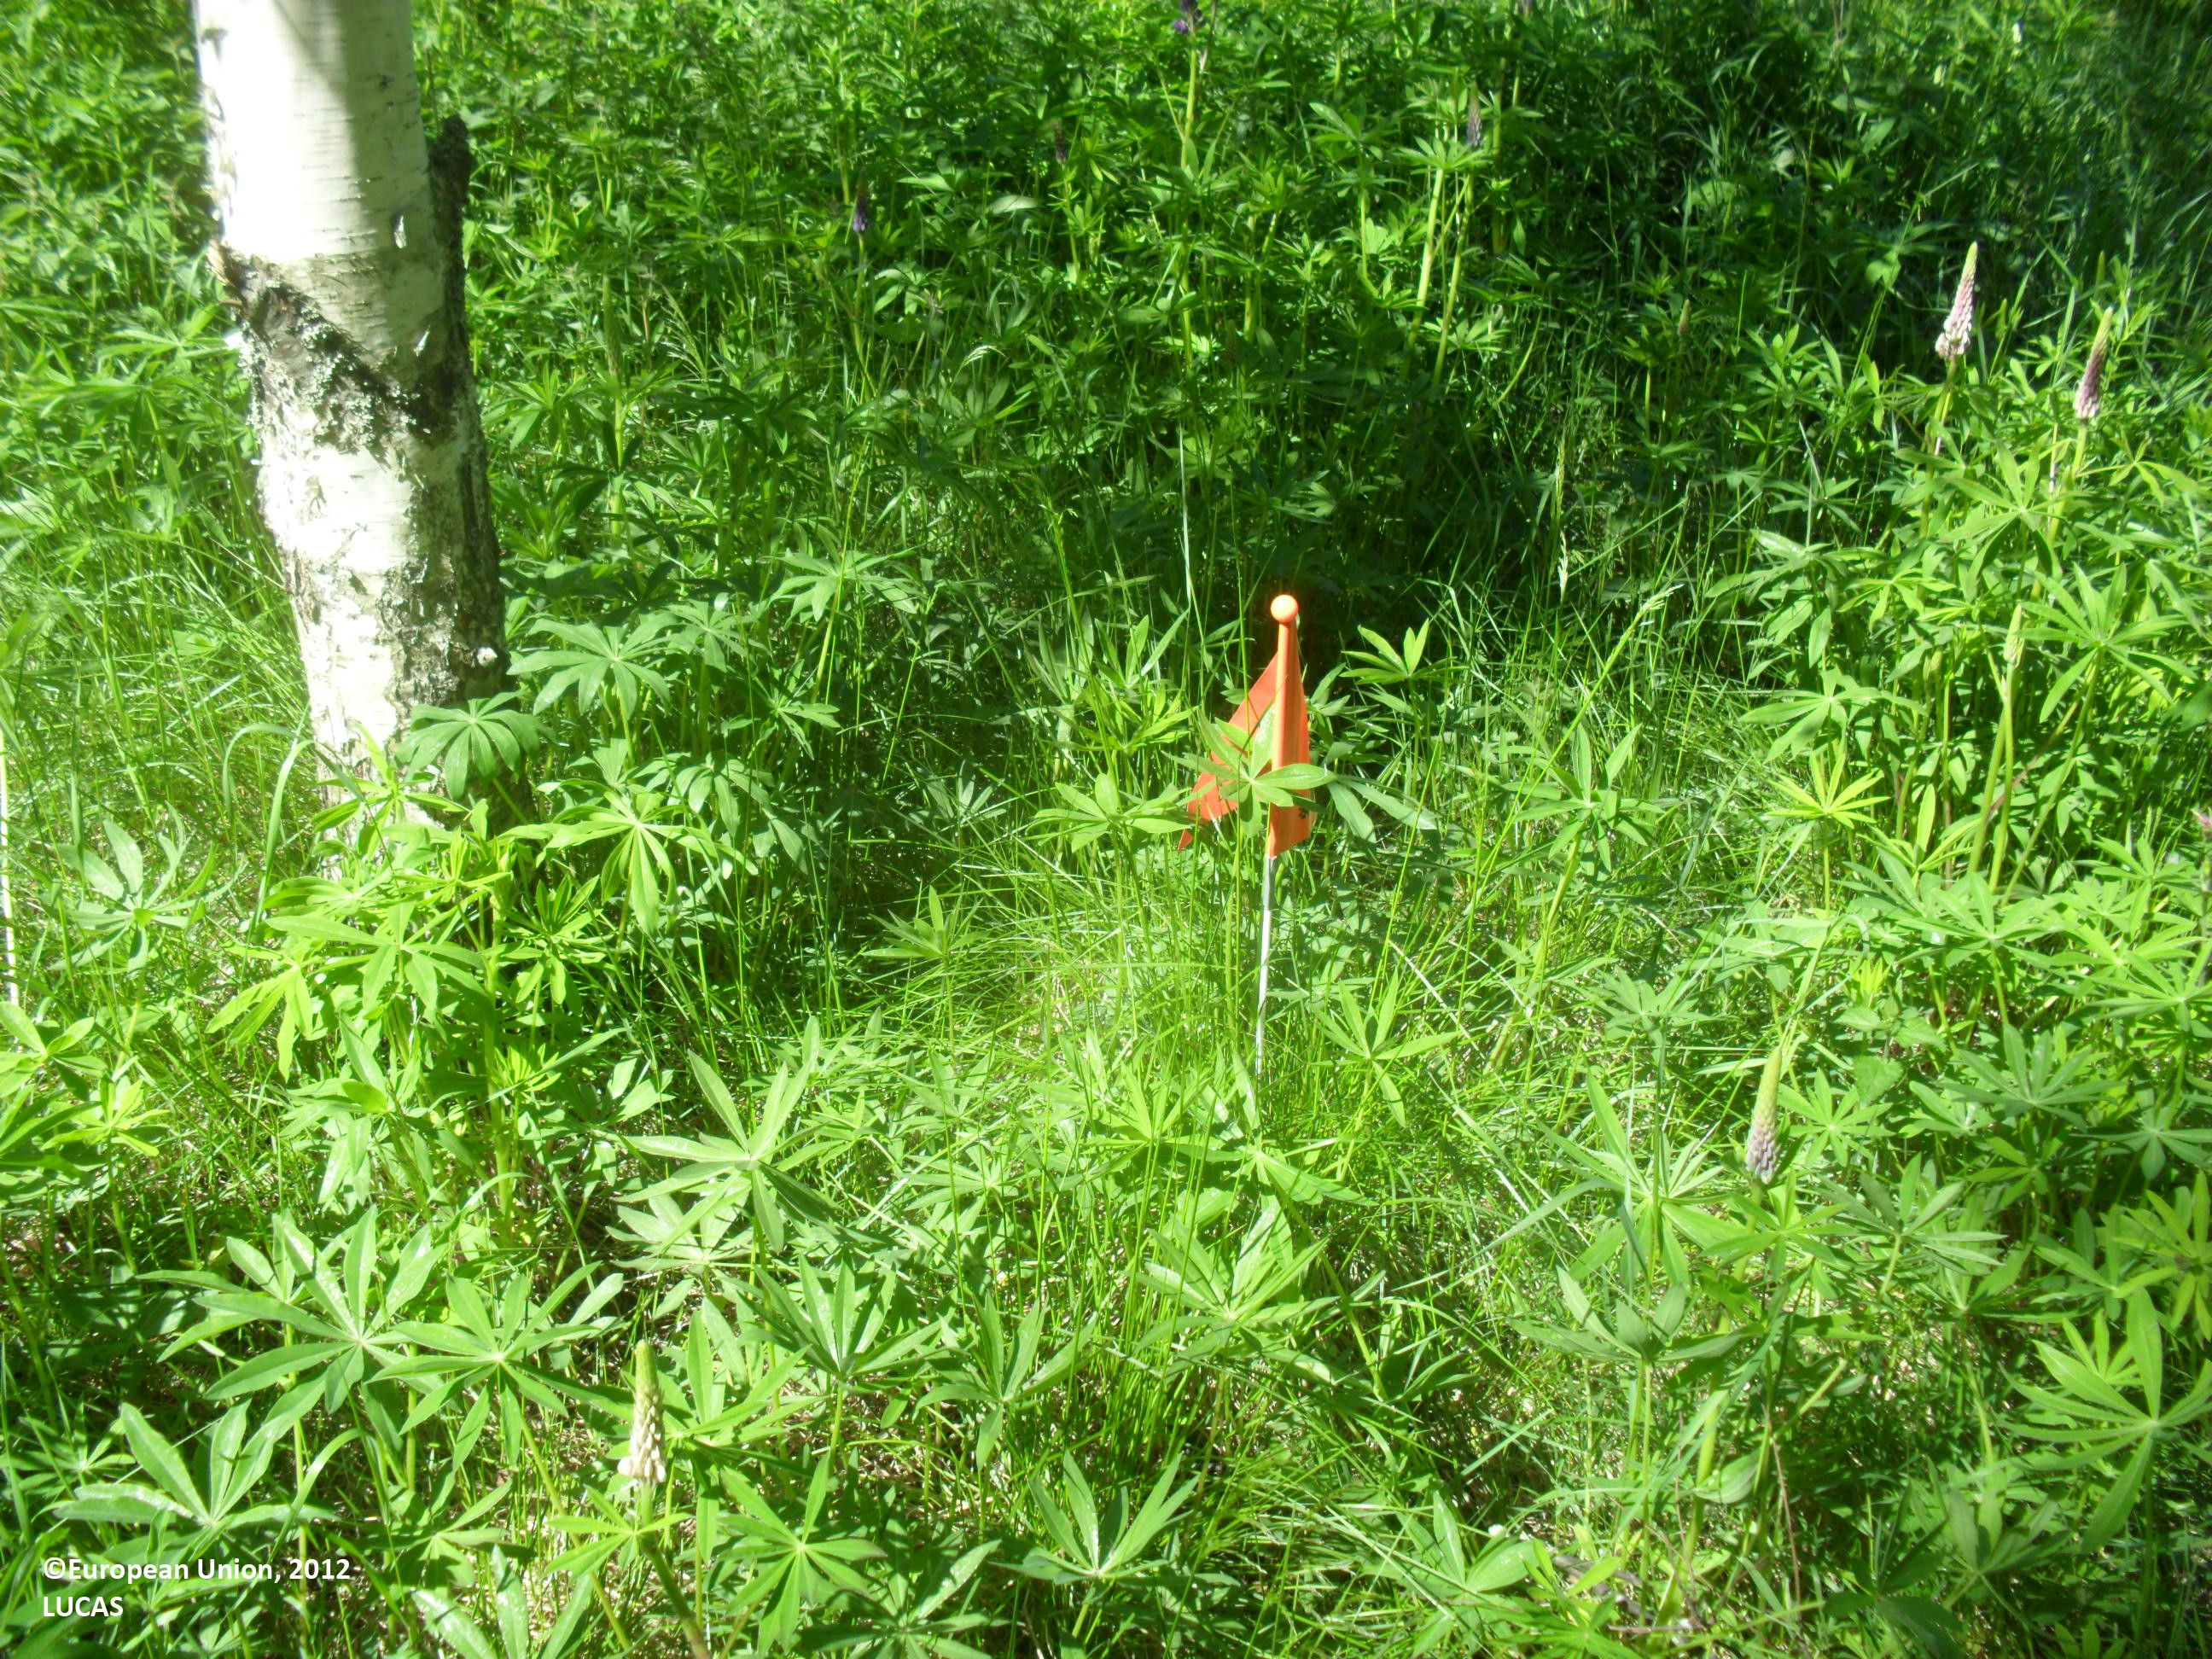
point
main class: Grassland
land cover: Grassland with sparse tree/shrub cover
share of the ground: 25 - 50 %
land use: Residential
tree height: > 5 m
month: June
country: FI
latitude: 63.2965
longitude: 23.1631
